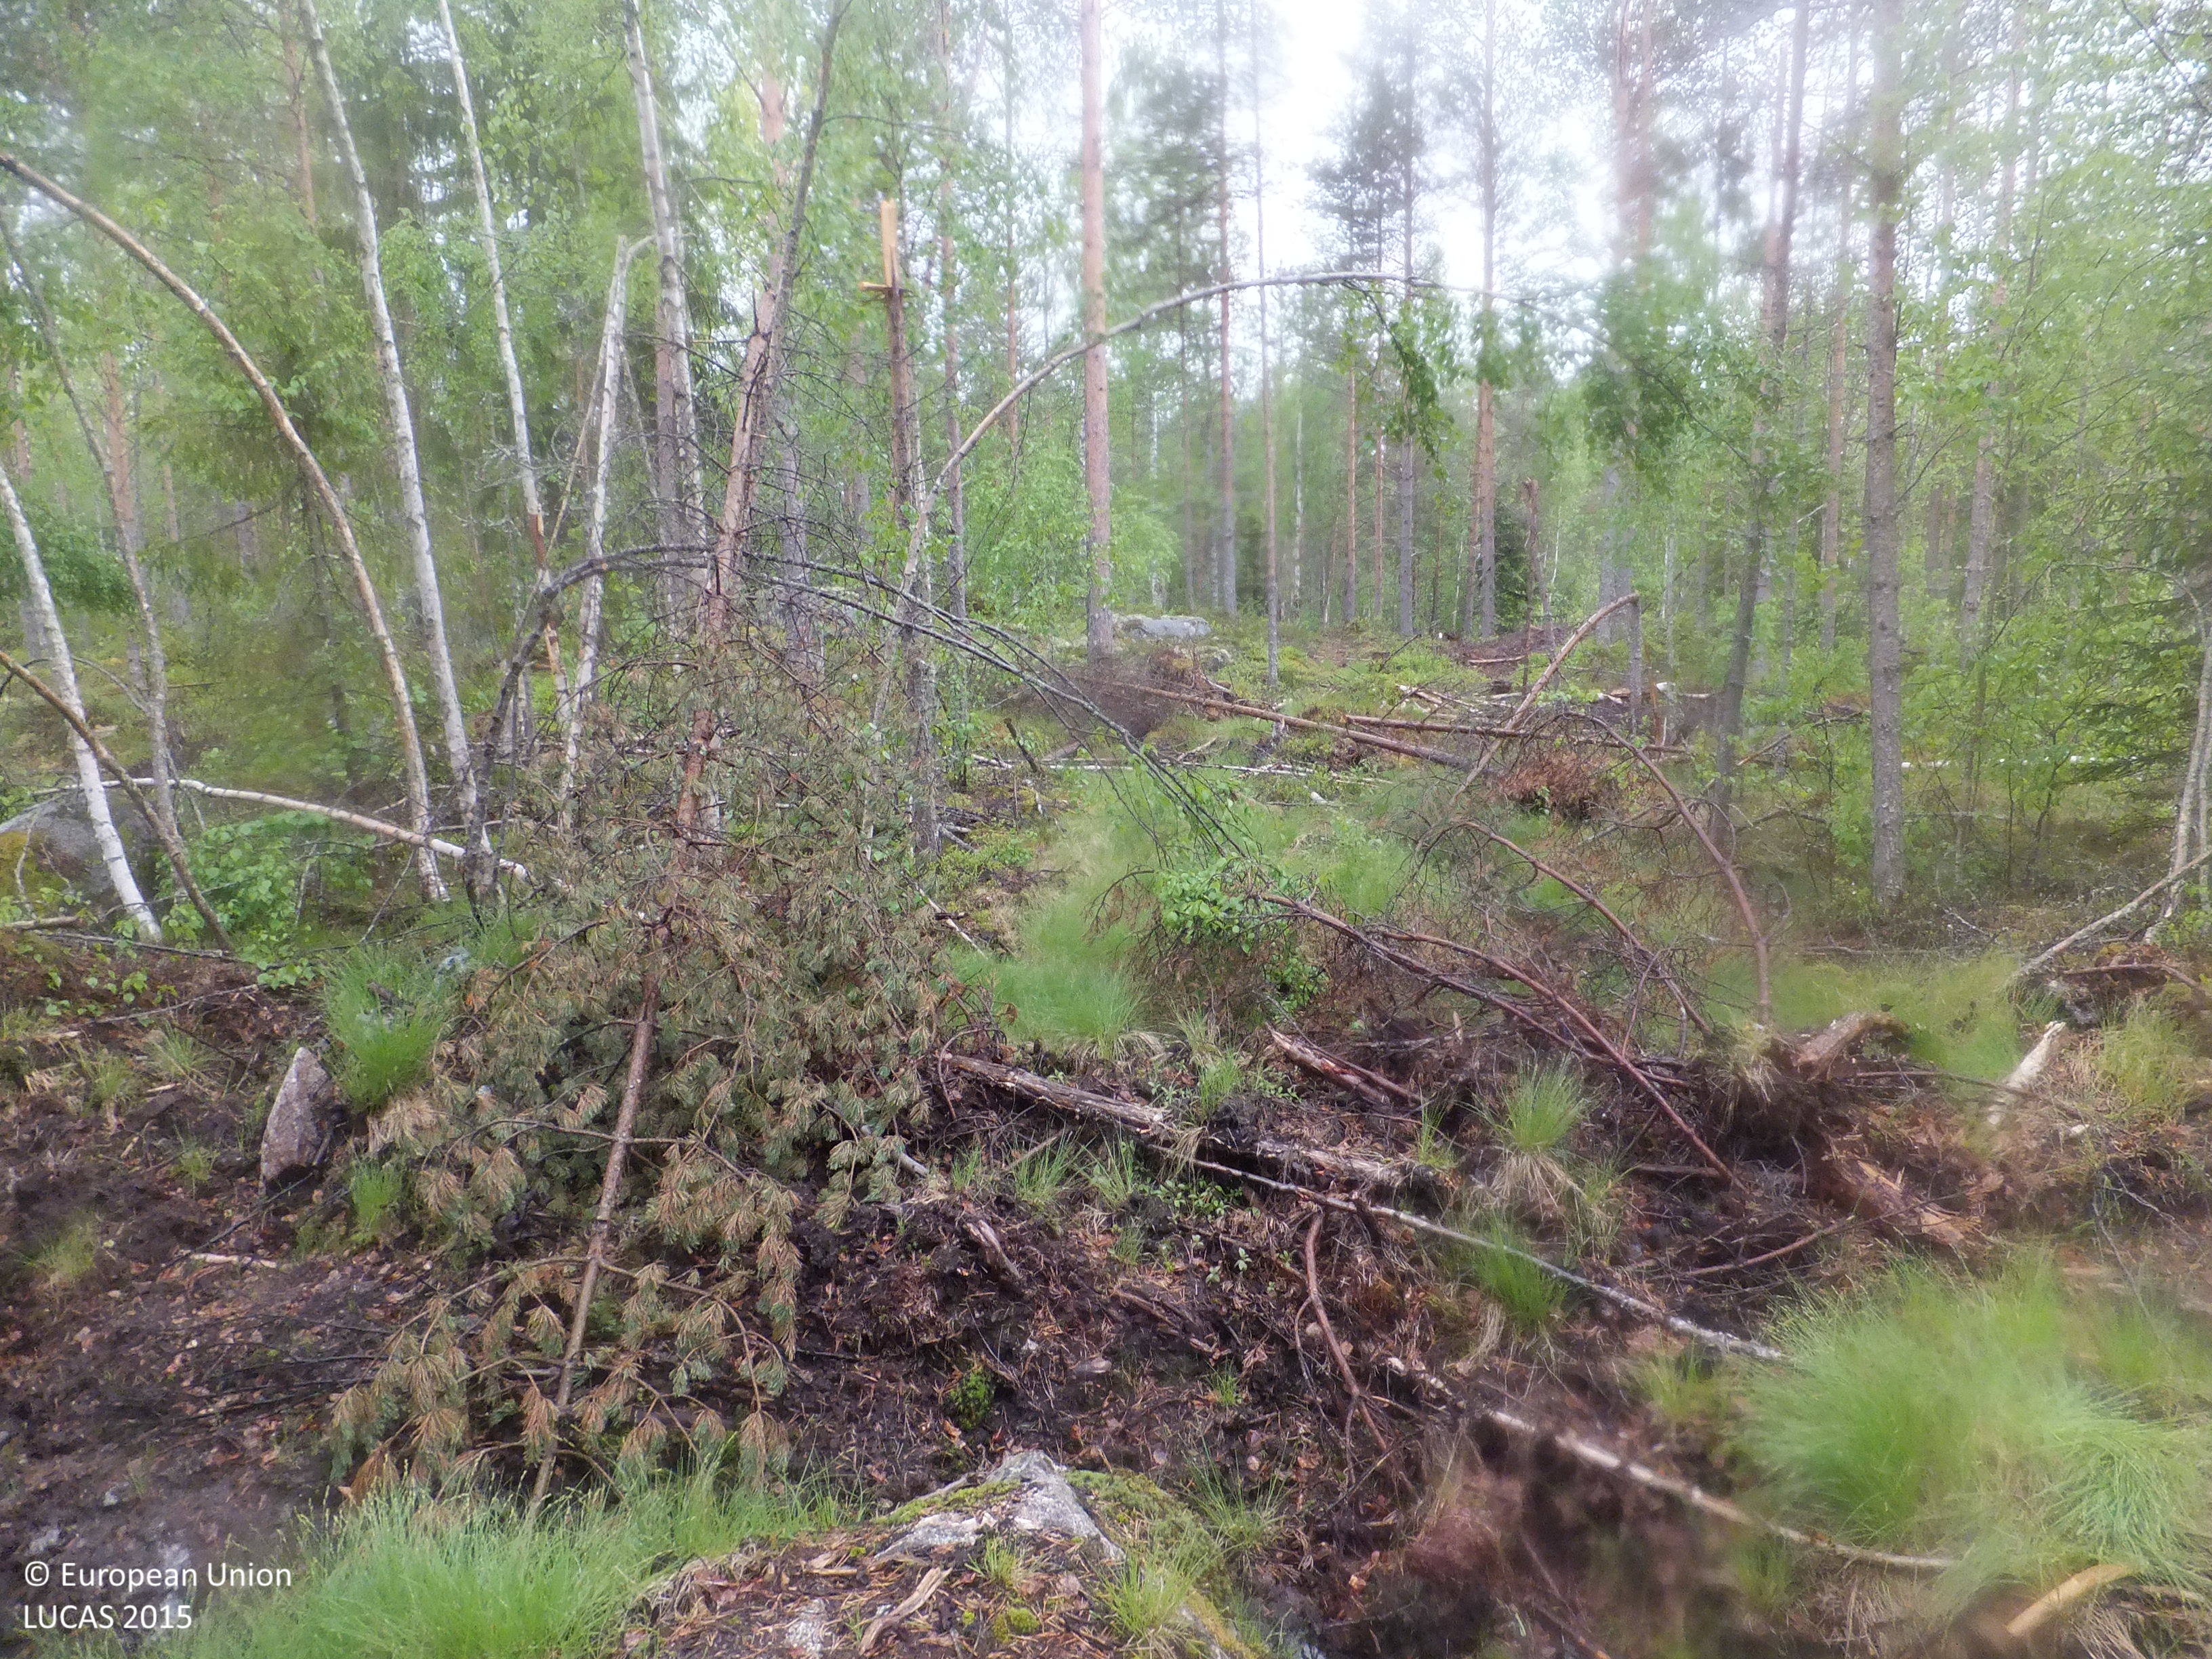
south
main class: Woodland
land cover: Pine dominated mixed woodland
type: boreal forest
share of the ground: 50 - 75 %
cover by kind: coniferous forest trees 30 %, broadleaved forest trees 30 %, herbaceous plants 15 %, shrubs 10 %, lichens and mosses 10 %, unconsolidated bare surface 5 %
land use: Forestry
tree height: > 5 m
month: June
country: FI
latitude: 63.7273
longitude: 24.8873
